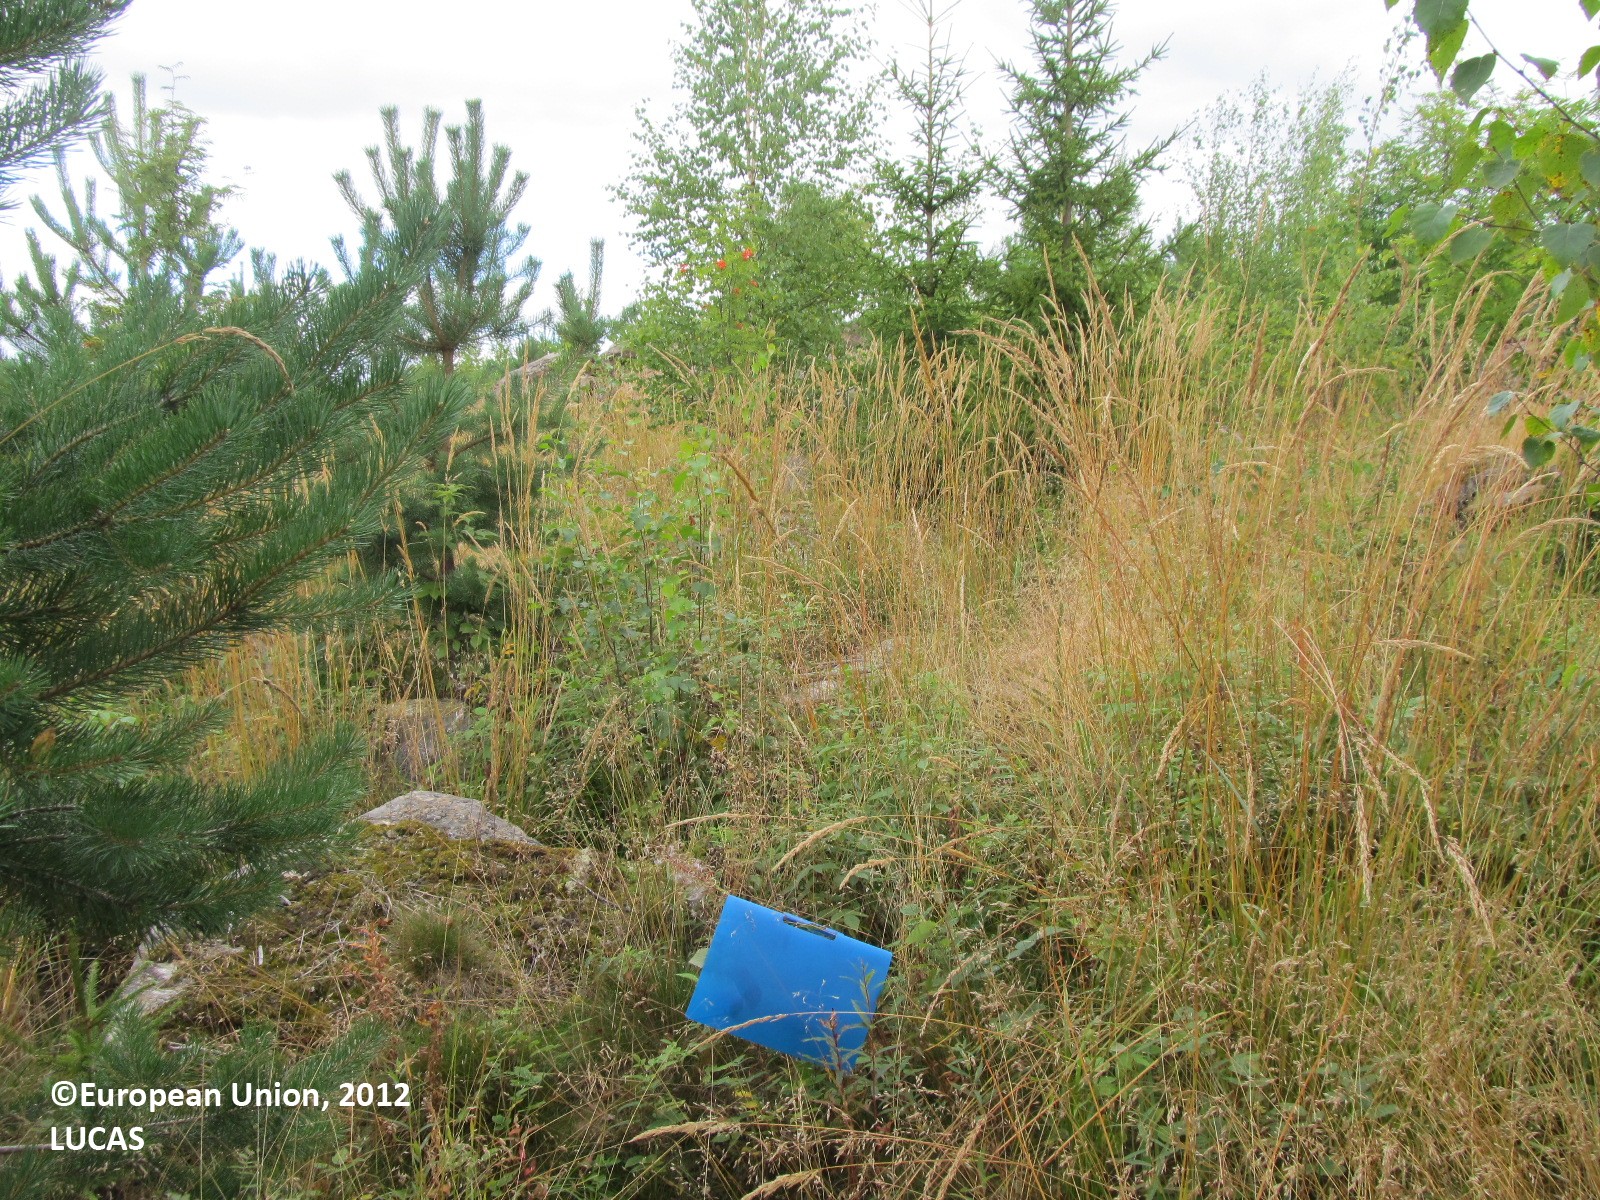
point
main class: Woodland
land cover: Spruce dominated mixed woodland
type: boreal forest
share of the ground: 25 - 50 %
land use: Forestry
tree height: < 5 m
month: August
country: FI
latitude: 61.7100
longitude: 27.7553
